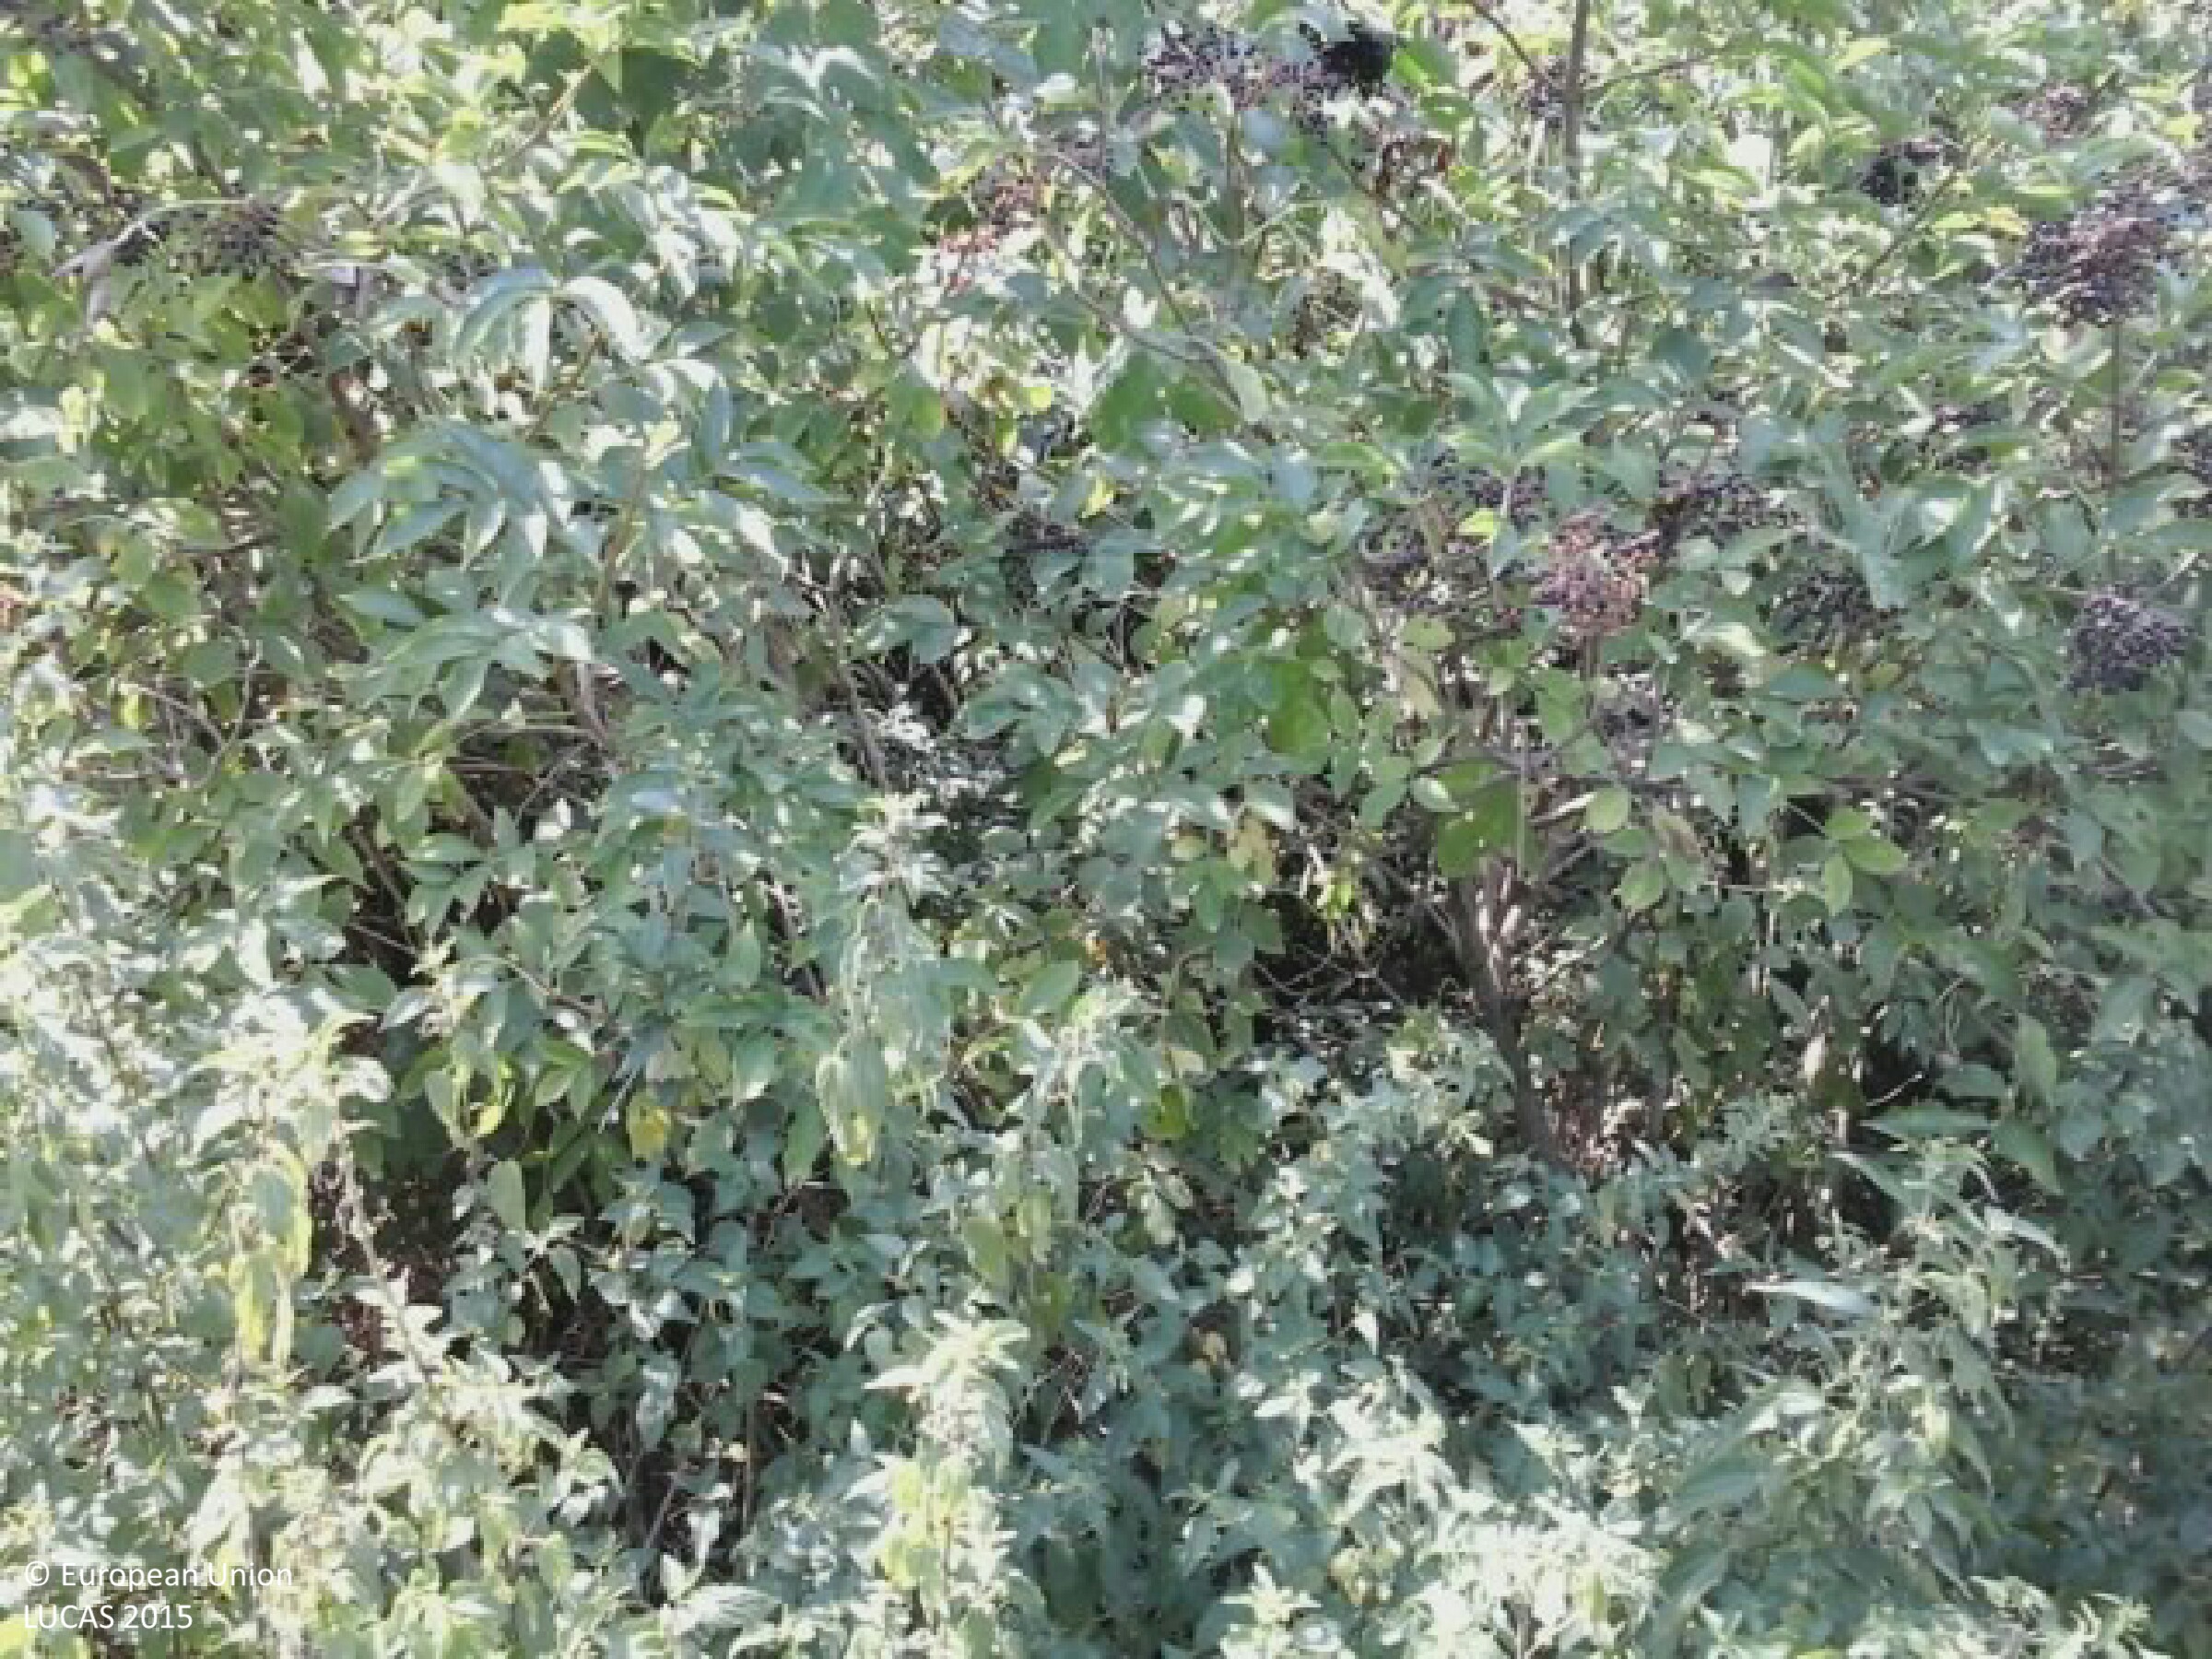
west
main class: Cropland
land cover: Maize
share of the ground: > 75 %
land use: Agriculture (excluding fallow land and kitchen gardens)
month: August
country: HU
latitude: 46.5767
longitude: 17.7442
